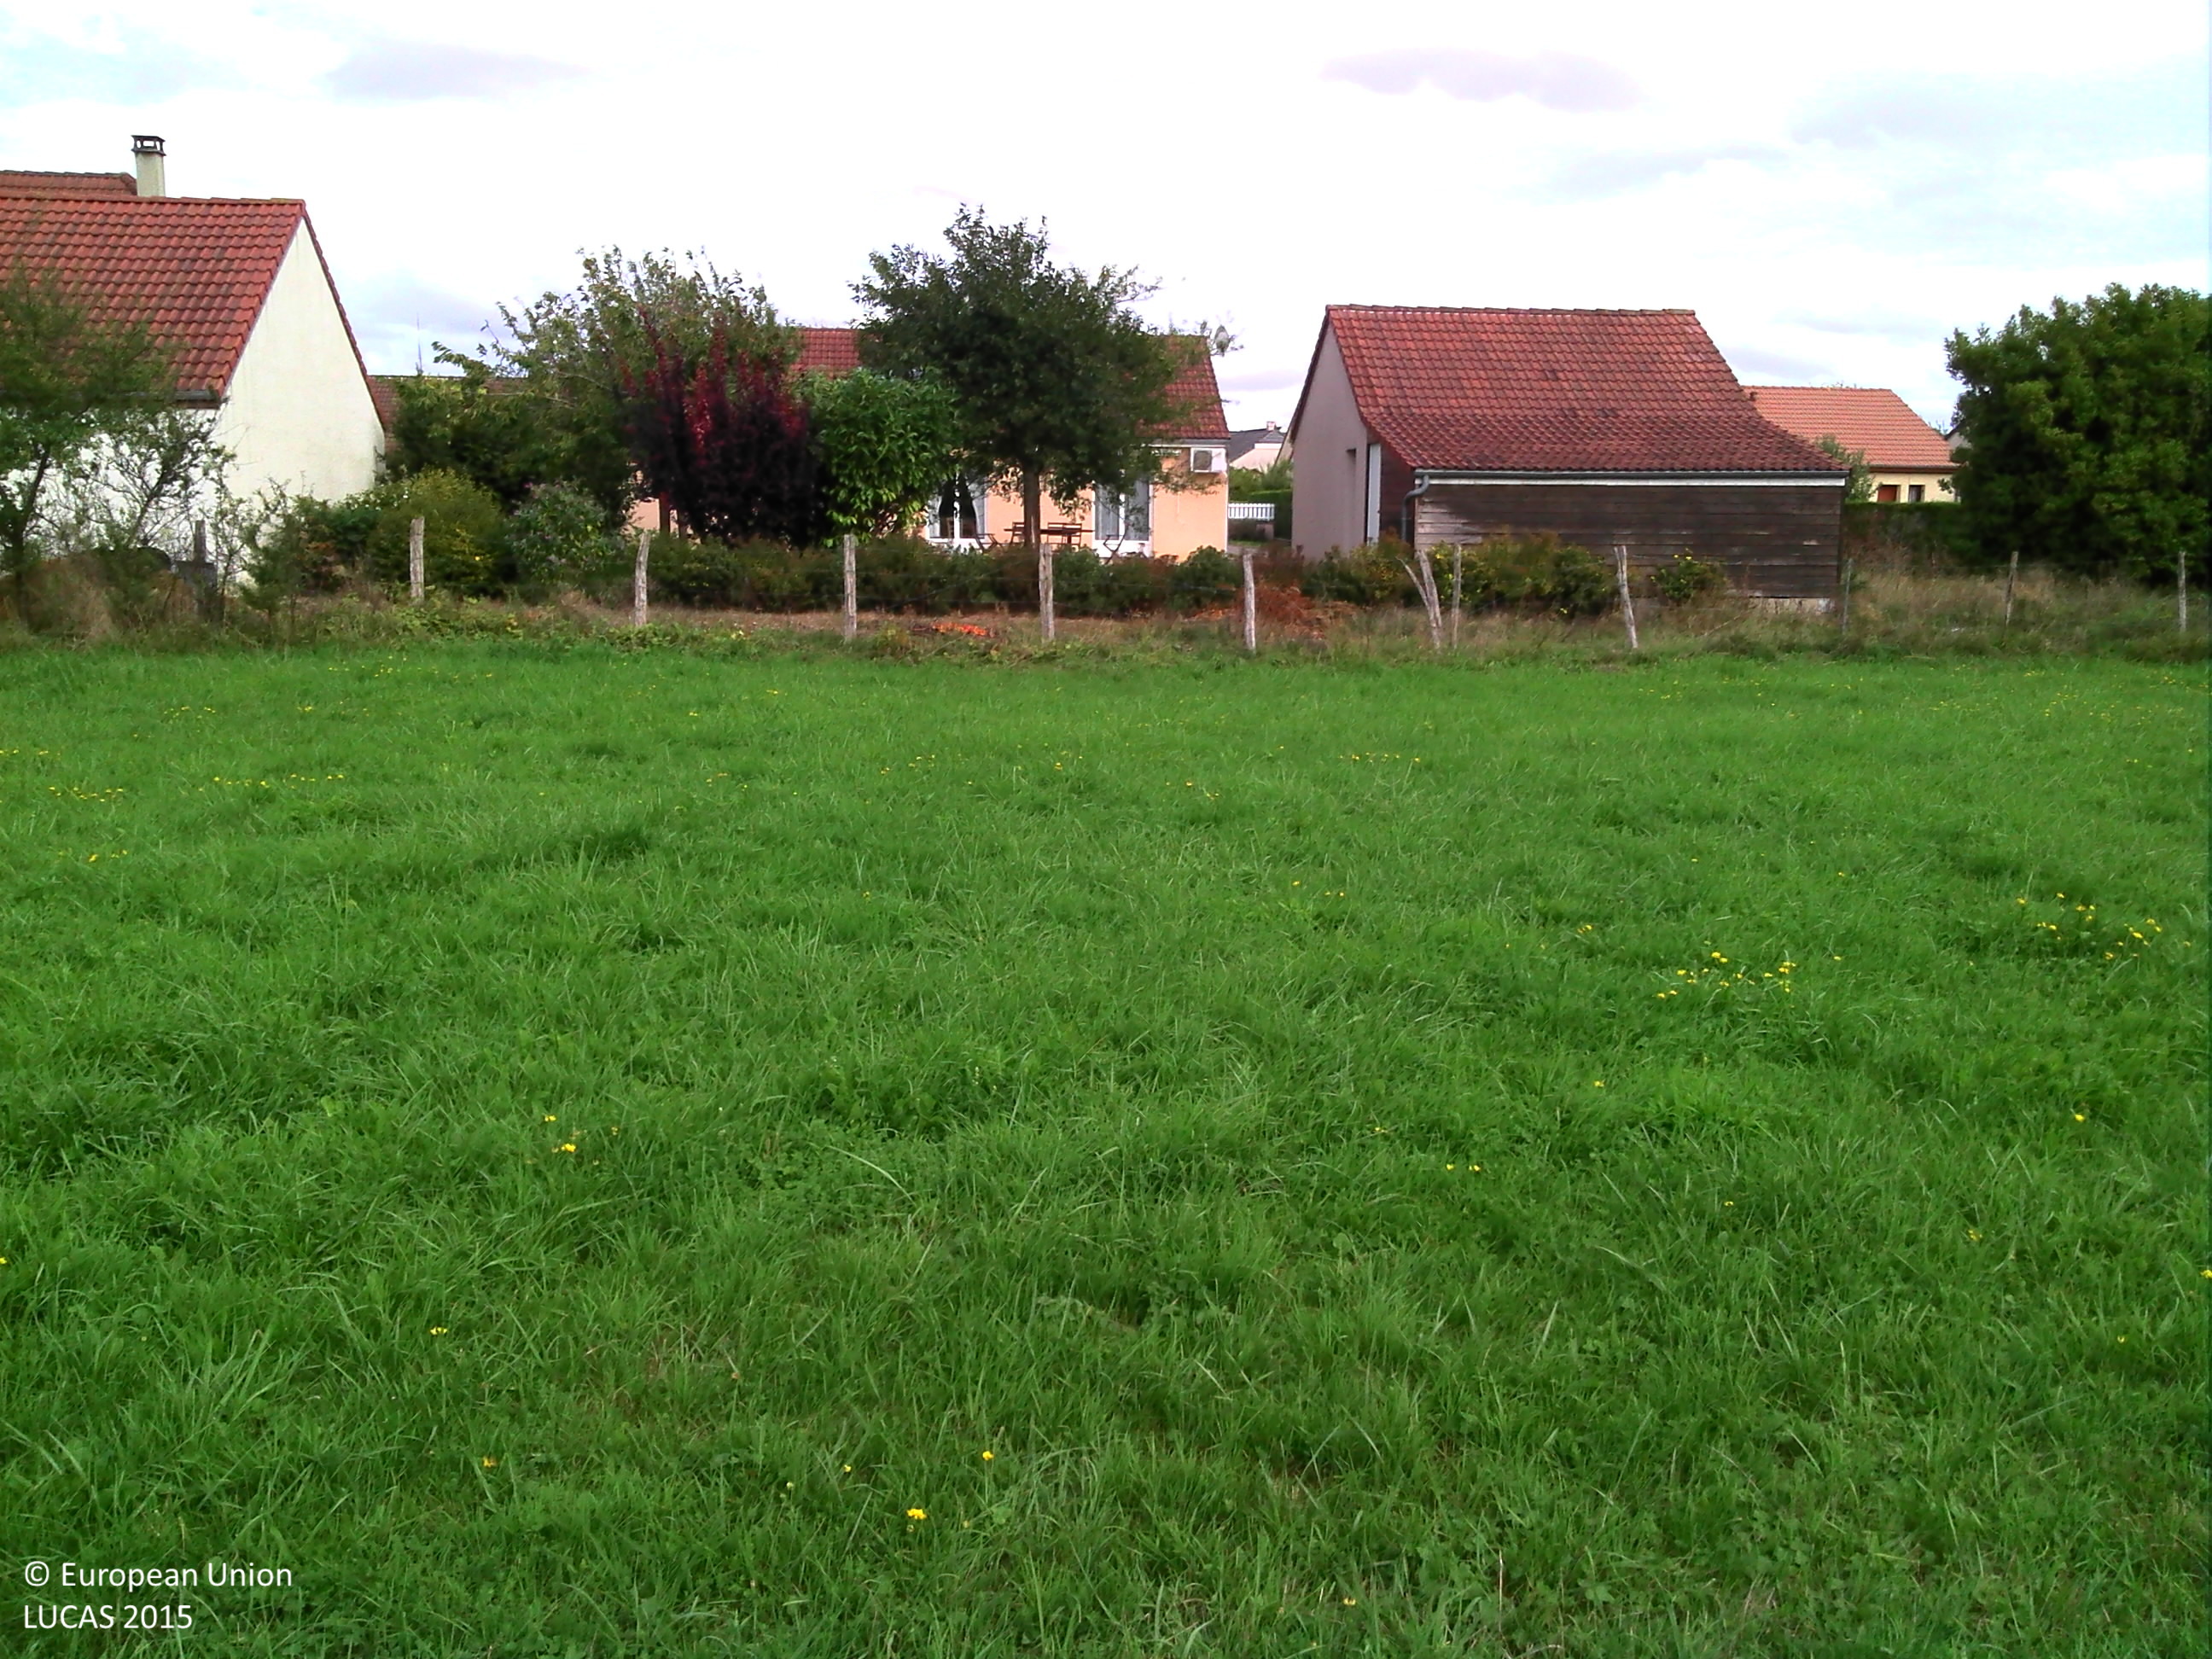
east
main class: Grassland
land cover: Grassland without tree/shrub cover
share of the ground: > 75 %
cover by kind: herbaceous plants 100 %
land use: Agriculture (excluding fallow land and kitchen gardens)
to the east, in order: Grassland without tree/shrub cover; Artificial constructions in urban areas
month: September
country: FR
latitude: 48.2227
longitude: 4.7082
